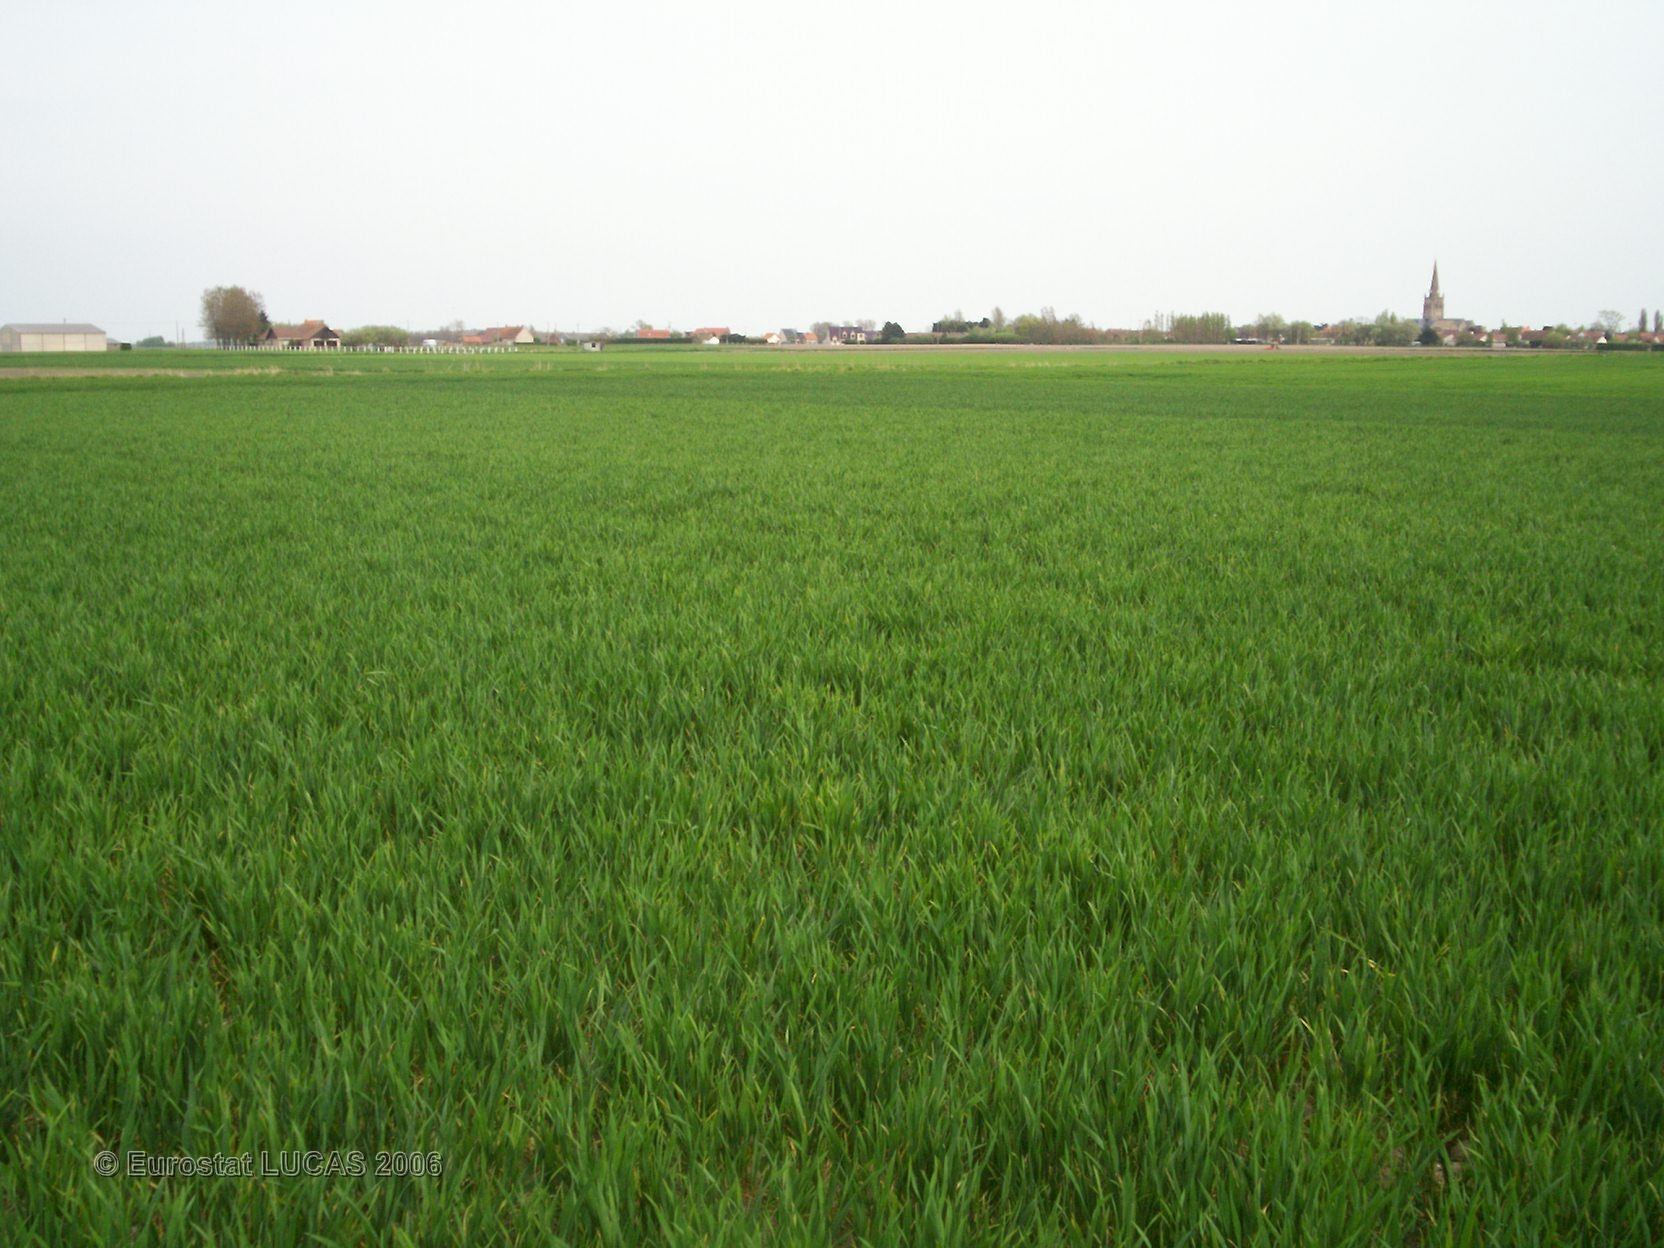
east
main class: Cropland
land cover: Common wheat
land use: Agriculture (excluding fallow land and kitchen gardens)
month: May
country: FR
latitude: 50.9832
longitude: 2.4802
